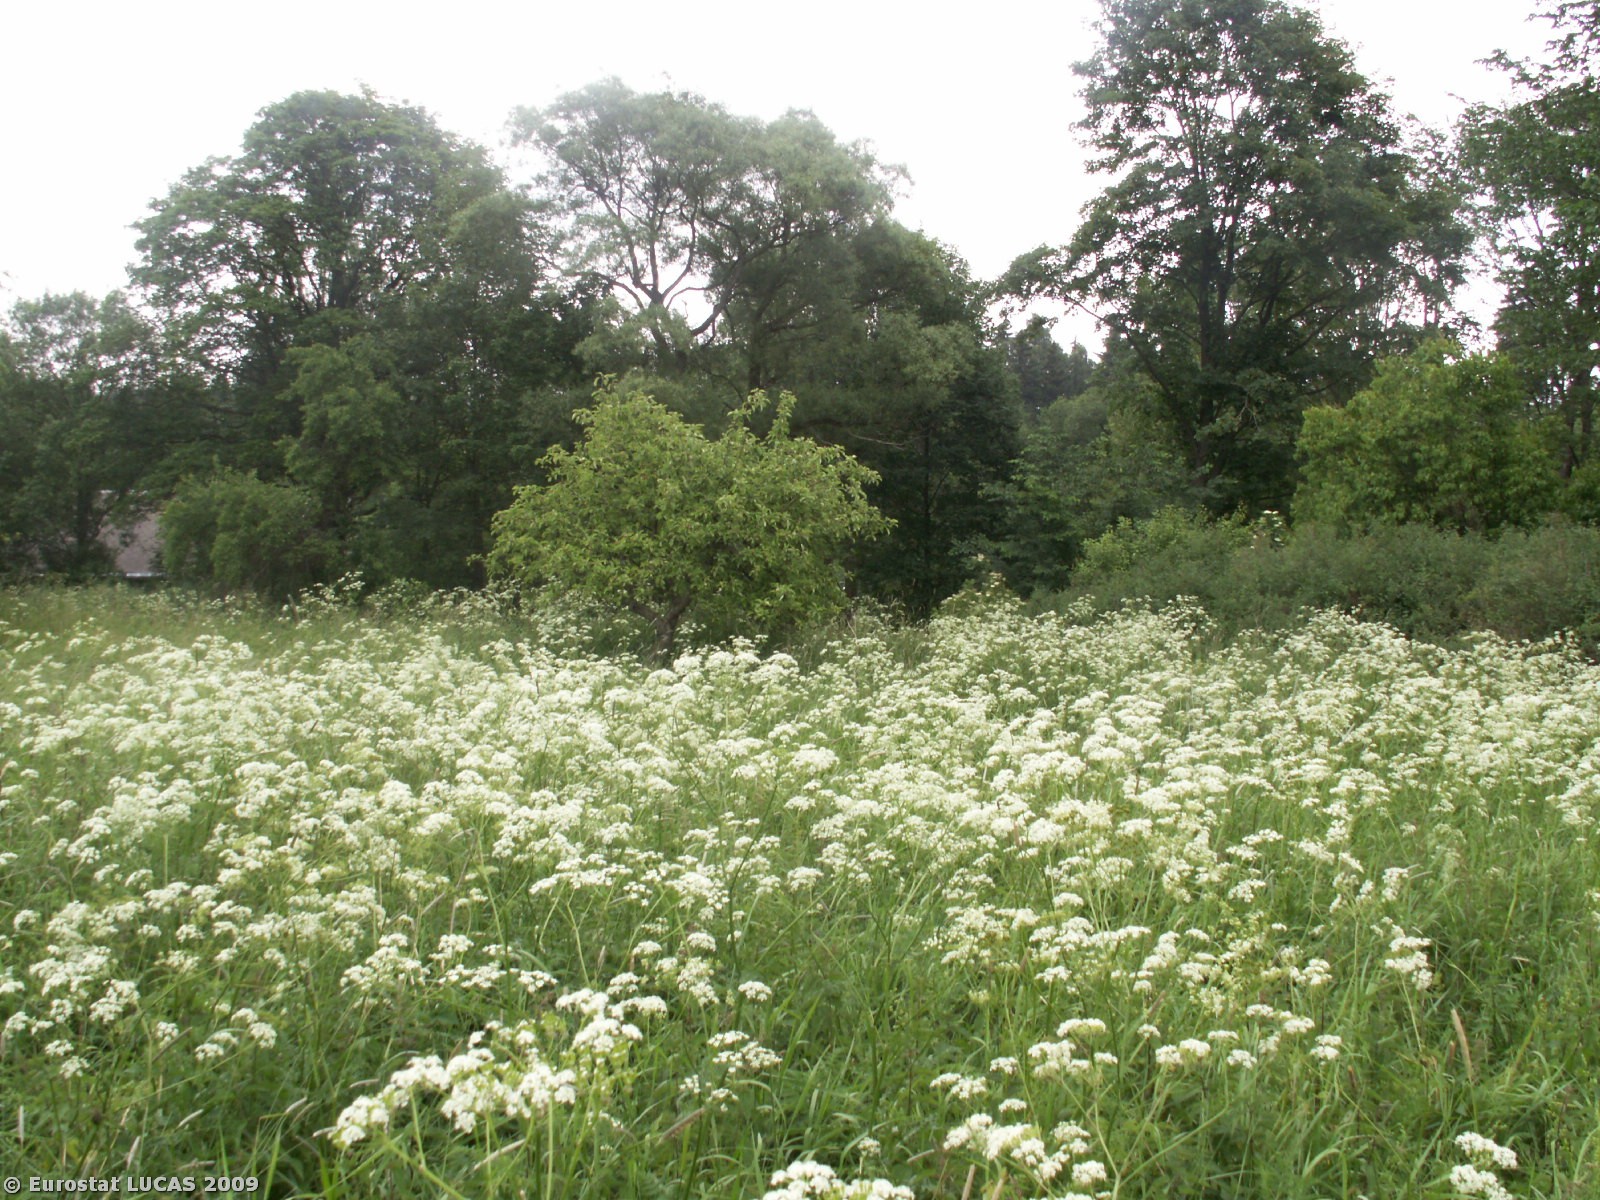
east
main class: Grassland
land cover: Spontaneously vegetated surfaces
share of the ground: > 75 %
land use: Fallow land
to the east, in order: Spontaneously vegetated surfaces; Apple fruit; Grassland with sparse tree/shrub cover; Broadleaved woodland; Ditches and canals; Paved roads, cycling and walking lanes; Electric lines; Grassland with sparse tree/shrub cover; Fences; Artificial constructions in urban areas; Fences; Broadleaved woodland; Rivers and streams; Broadleaved woodland; Grassland with sparse tree/shrub cover; Rivers and streams; Grassland with sparse tree/shrub cover; Tracks; Artificial constructions in urban areas; Fences; Broadleaved woodland; Coniferous woodland
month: June
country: CZ
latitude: 50.1625
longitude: 13.0096
